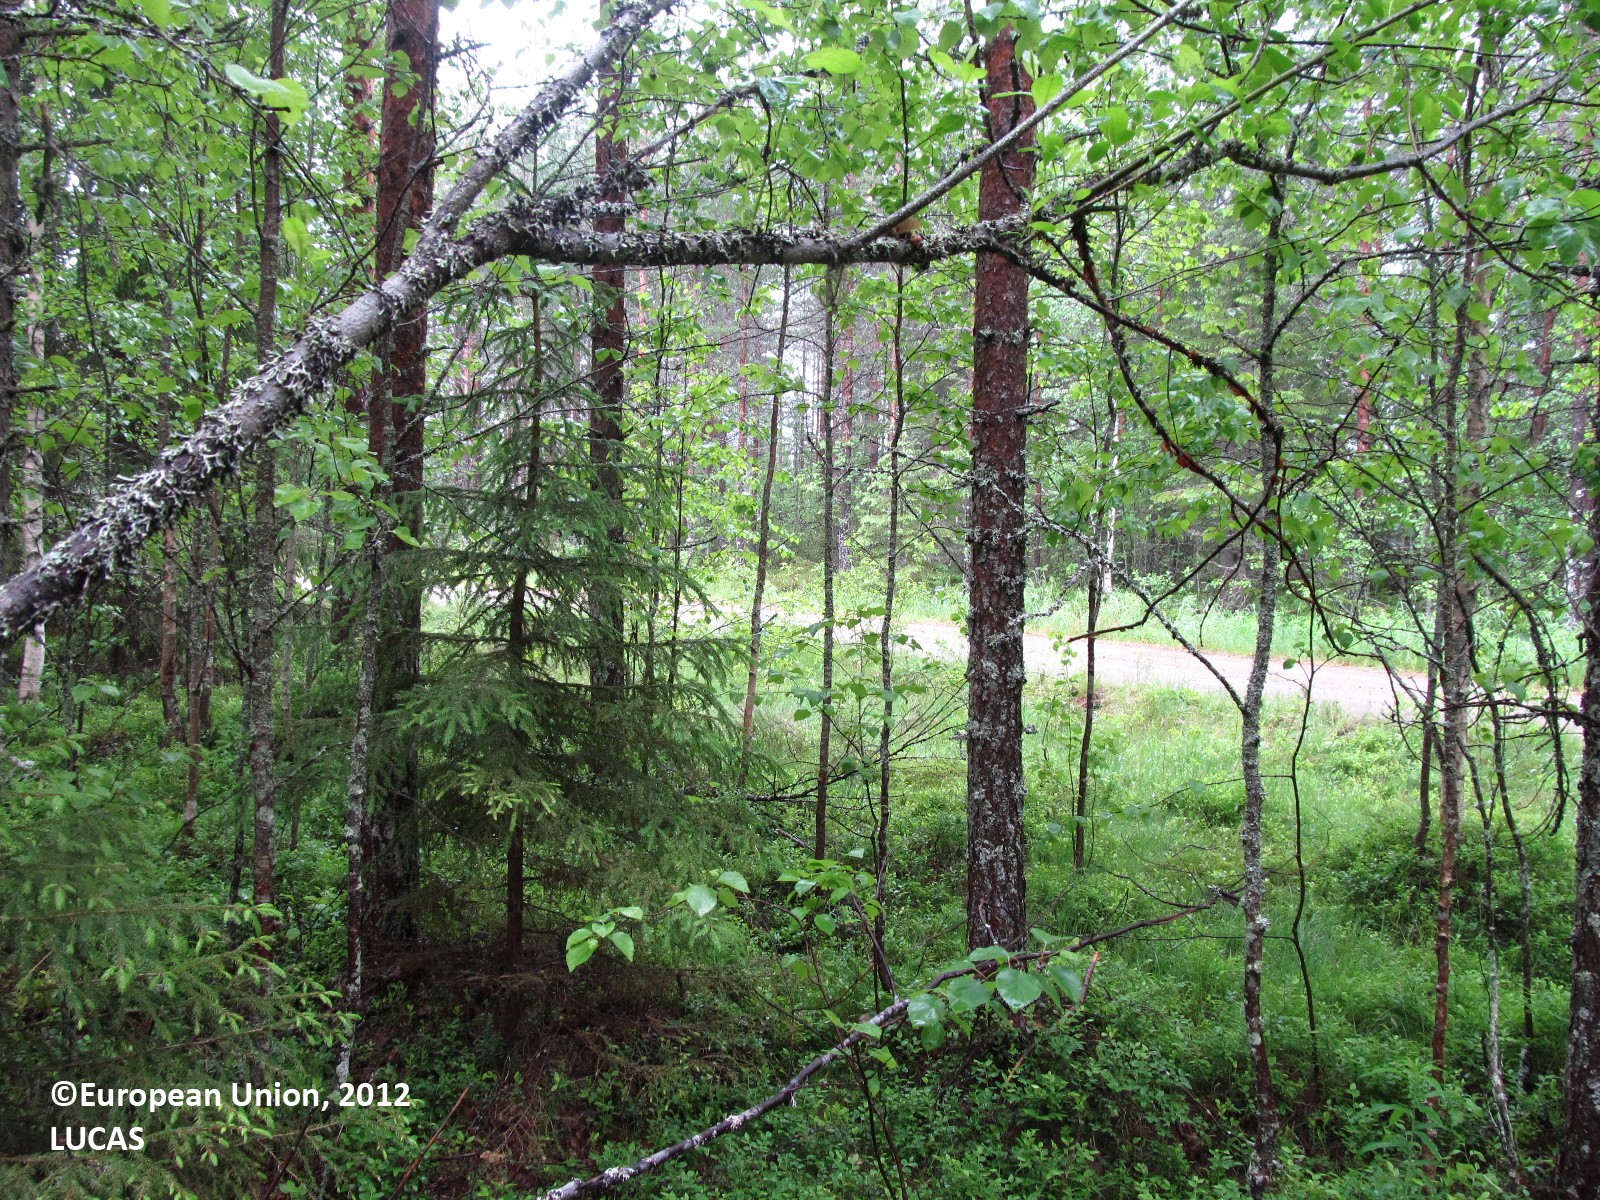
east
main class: Woodland
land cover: Pine dominated mixed woodland
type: boreal forest
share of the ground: 50 - 75 %
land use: Forestry
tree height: > 5 m
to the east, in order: Pine dominated mixed woodland; Paved roads, cycling and walking lanes; Grass margins; Ditches and canals; Pine dominated mixed woodland; Ditches and canals; Pine dominated mixed woodland; Ditches and canals; Pine dominated mixed woodland; Ditches and canals; Pine dominated mixed woodland; Ditches and canals; Pine dominated mixed woodland; Spruce dominated coniferous woodland; Pine dominated mixed woodland; Spruce dominated mixed woodland
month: June
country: FI
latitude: 63.0722
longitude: 29.0783
